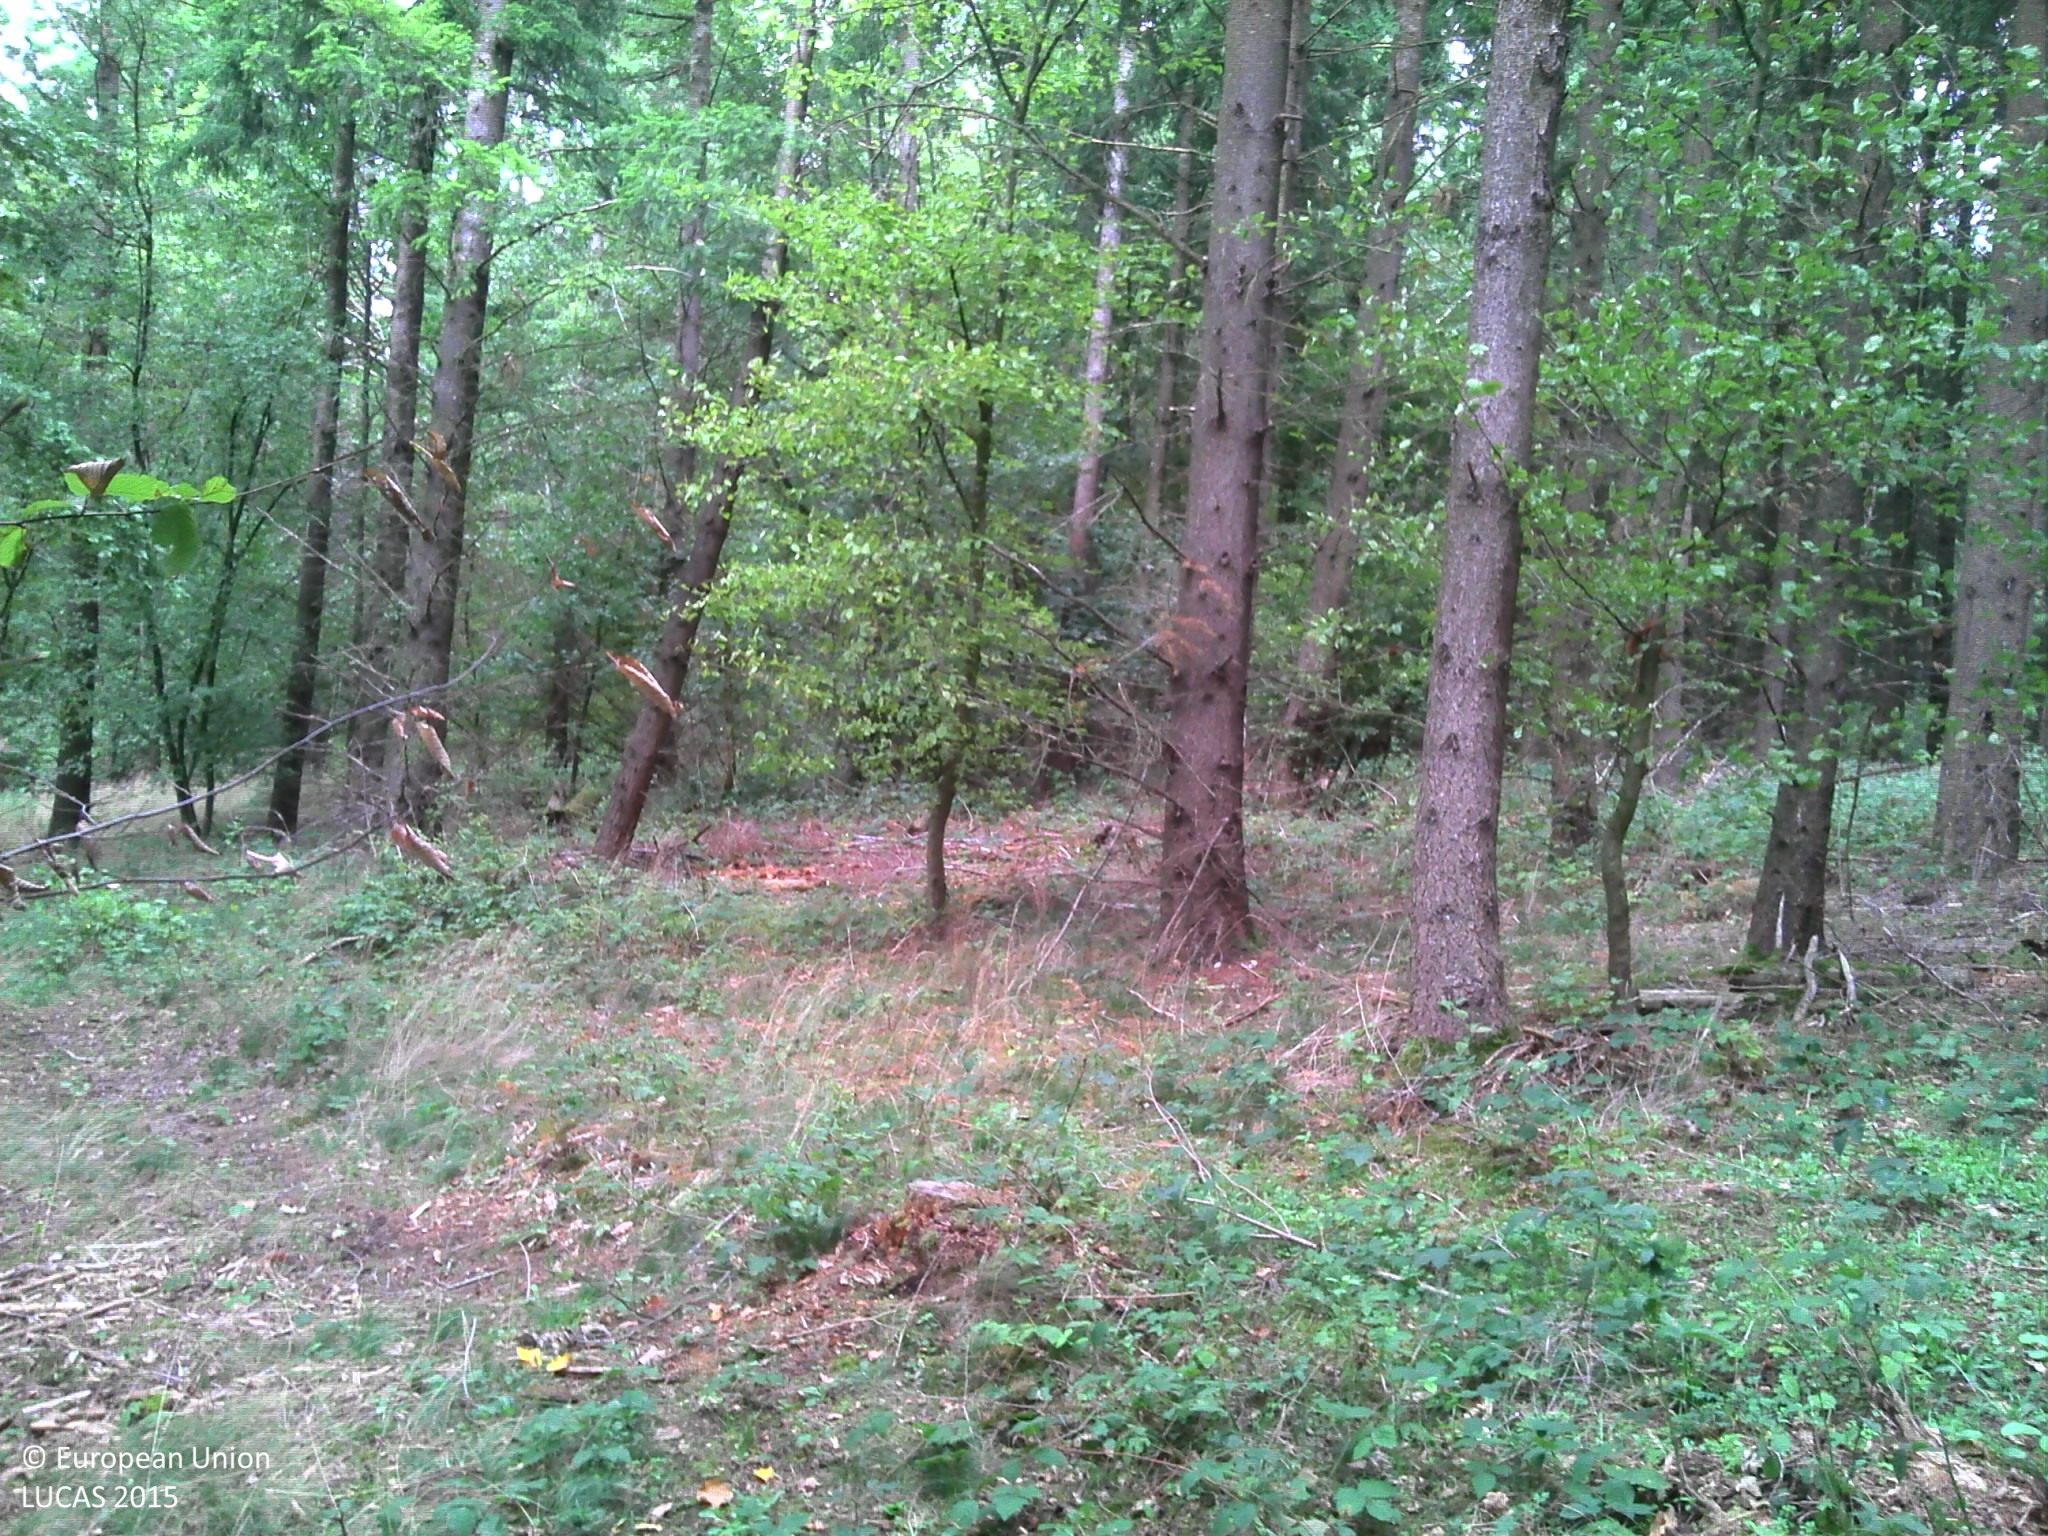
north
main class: Woodland
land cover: Other coniferous woodland
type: exotic forest
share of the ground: > 75 %
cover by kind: coniferous forest trees 85 %, broadleaved forest trees 5 %, herbaceous plants 5 %, lichens and mosses 5 %
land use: Forestry
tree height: > 5 m
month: September
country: FR
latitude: 48.2498
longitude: 3.8410
